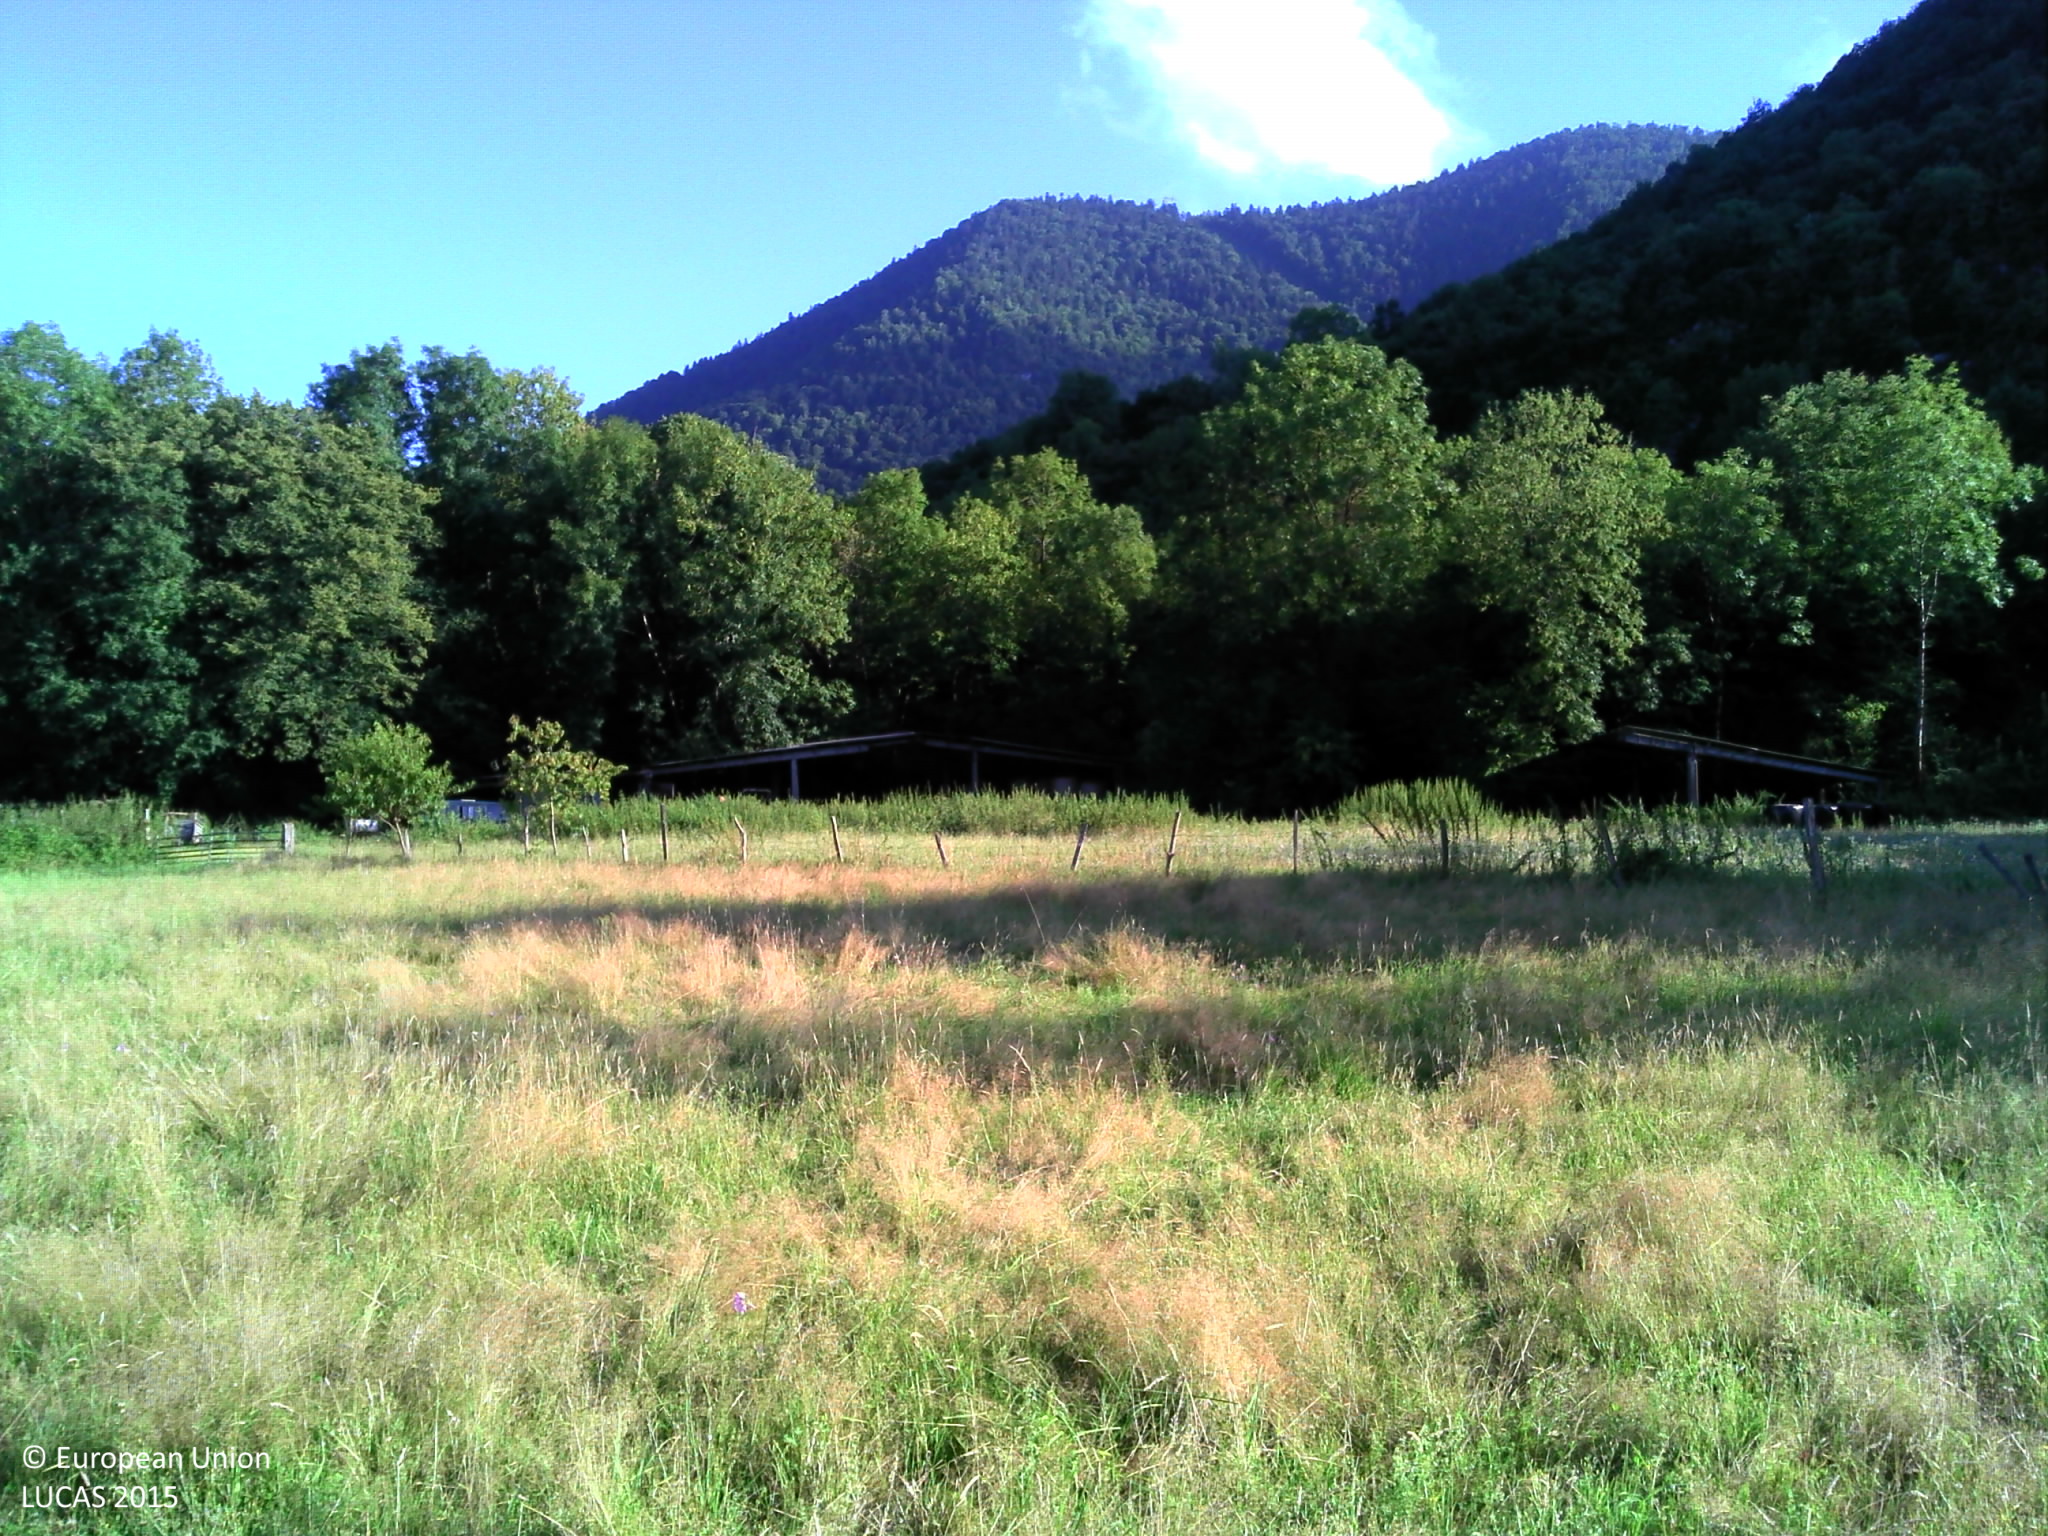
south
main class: Grassland
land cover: Grassland without tree/shrub cover
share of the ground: > 75 %
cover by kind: herbaceous plants 100 %
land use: Agriculture (excluding fallow land and kitchen gardens)
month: July
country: FR
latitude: 43.0957
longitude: -0.4365
